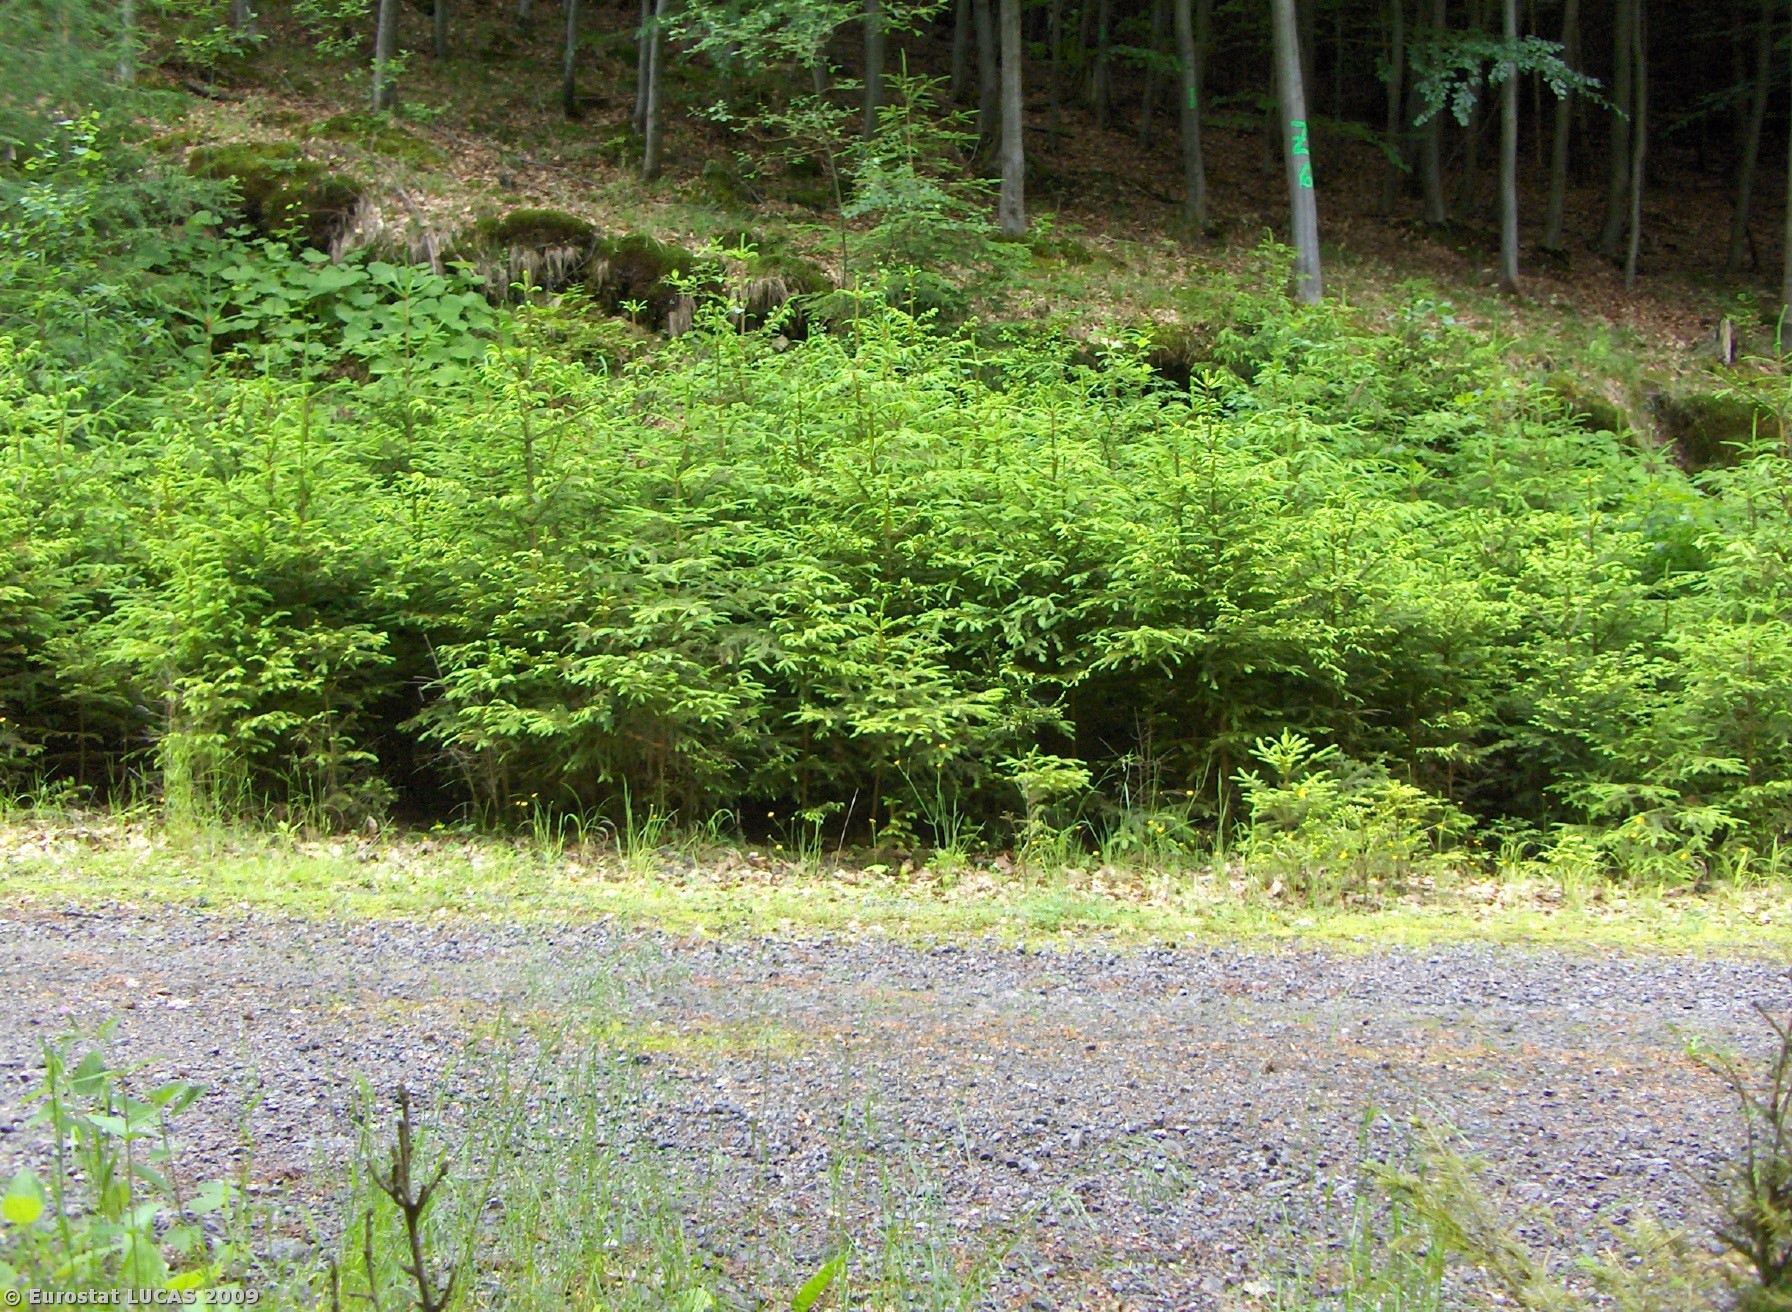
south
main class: Woodland
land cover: Mixed woodland
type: hemiboreal forest and nemoral coniferous forest and mixed broadleaved-coniferous forest
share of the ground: > 75 %
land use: Forestry
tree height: > 5 m
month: May
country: CZ
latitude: 49.1066
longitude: 14.4531
